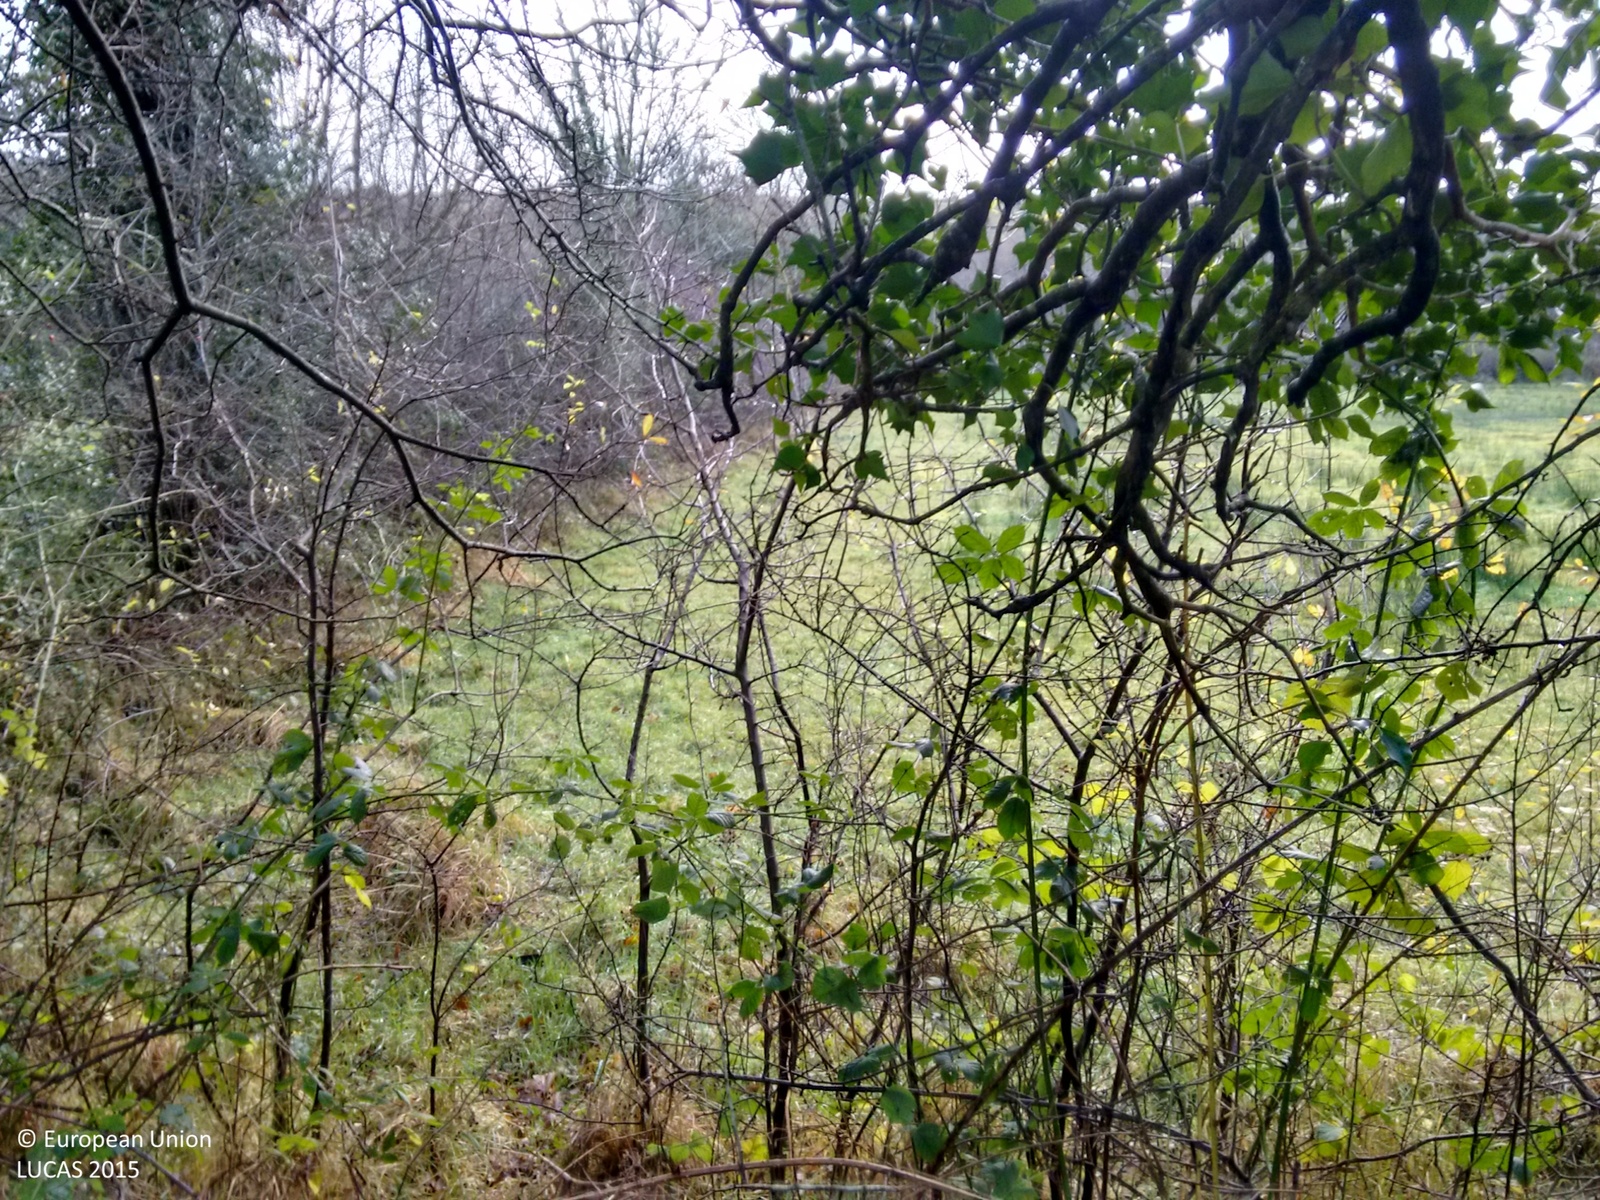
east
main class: Grassland
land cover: Grassland without tree/shrub cover
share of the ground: > 75 %
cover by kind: herbaceous plants 100 %
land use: Agriculture (excluding fallow land and kitchen gardens)
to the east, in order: Grassland without tree/shrub cover; Fences; Rivers and streams; Lines of trees; Grassland without tree/shrub cover; Abandoned hedges; Fences; Dry stone walls; Electric lines; Paved roads, cycling and walking lanes; Ditches and canals; Abandoned hedges; Fences; Grassland without tree/shrub cover; Paved roads, cycling and walking lanes; Grassland without tree/shrub cover
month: December
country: IE
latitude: 54.2134
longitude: -8.0077
